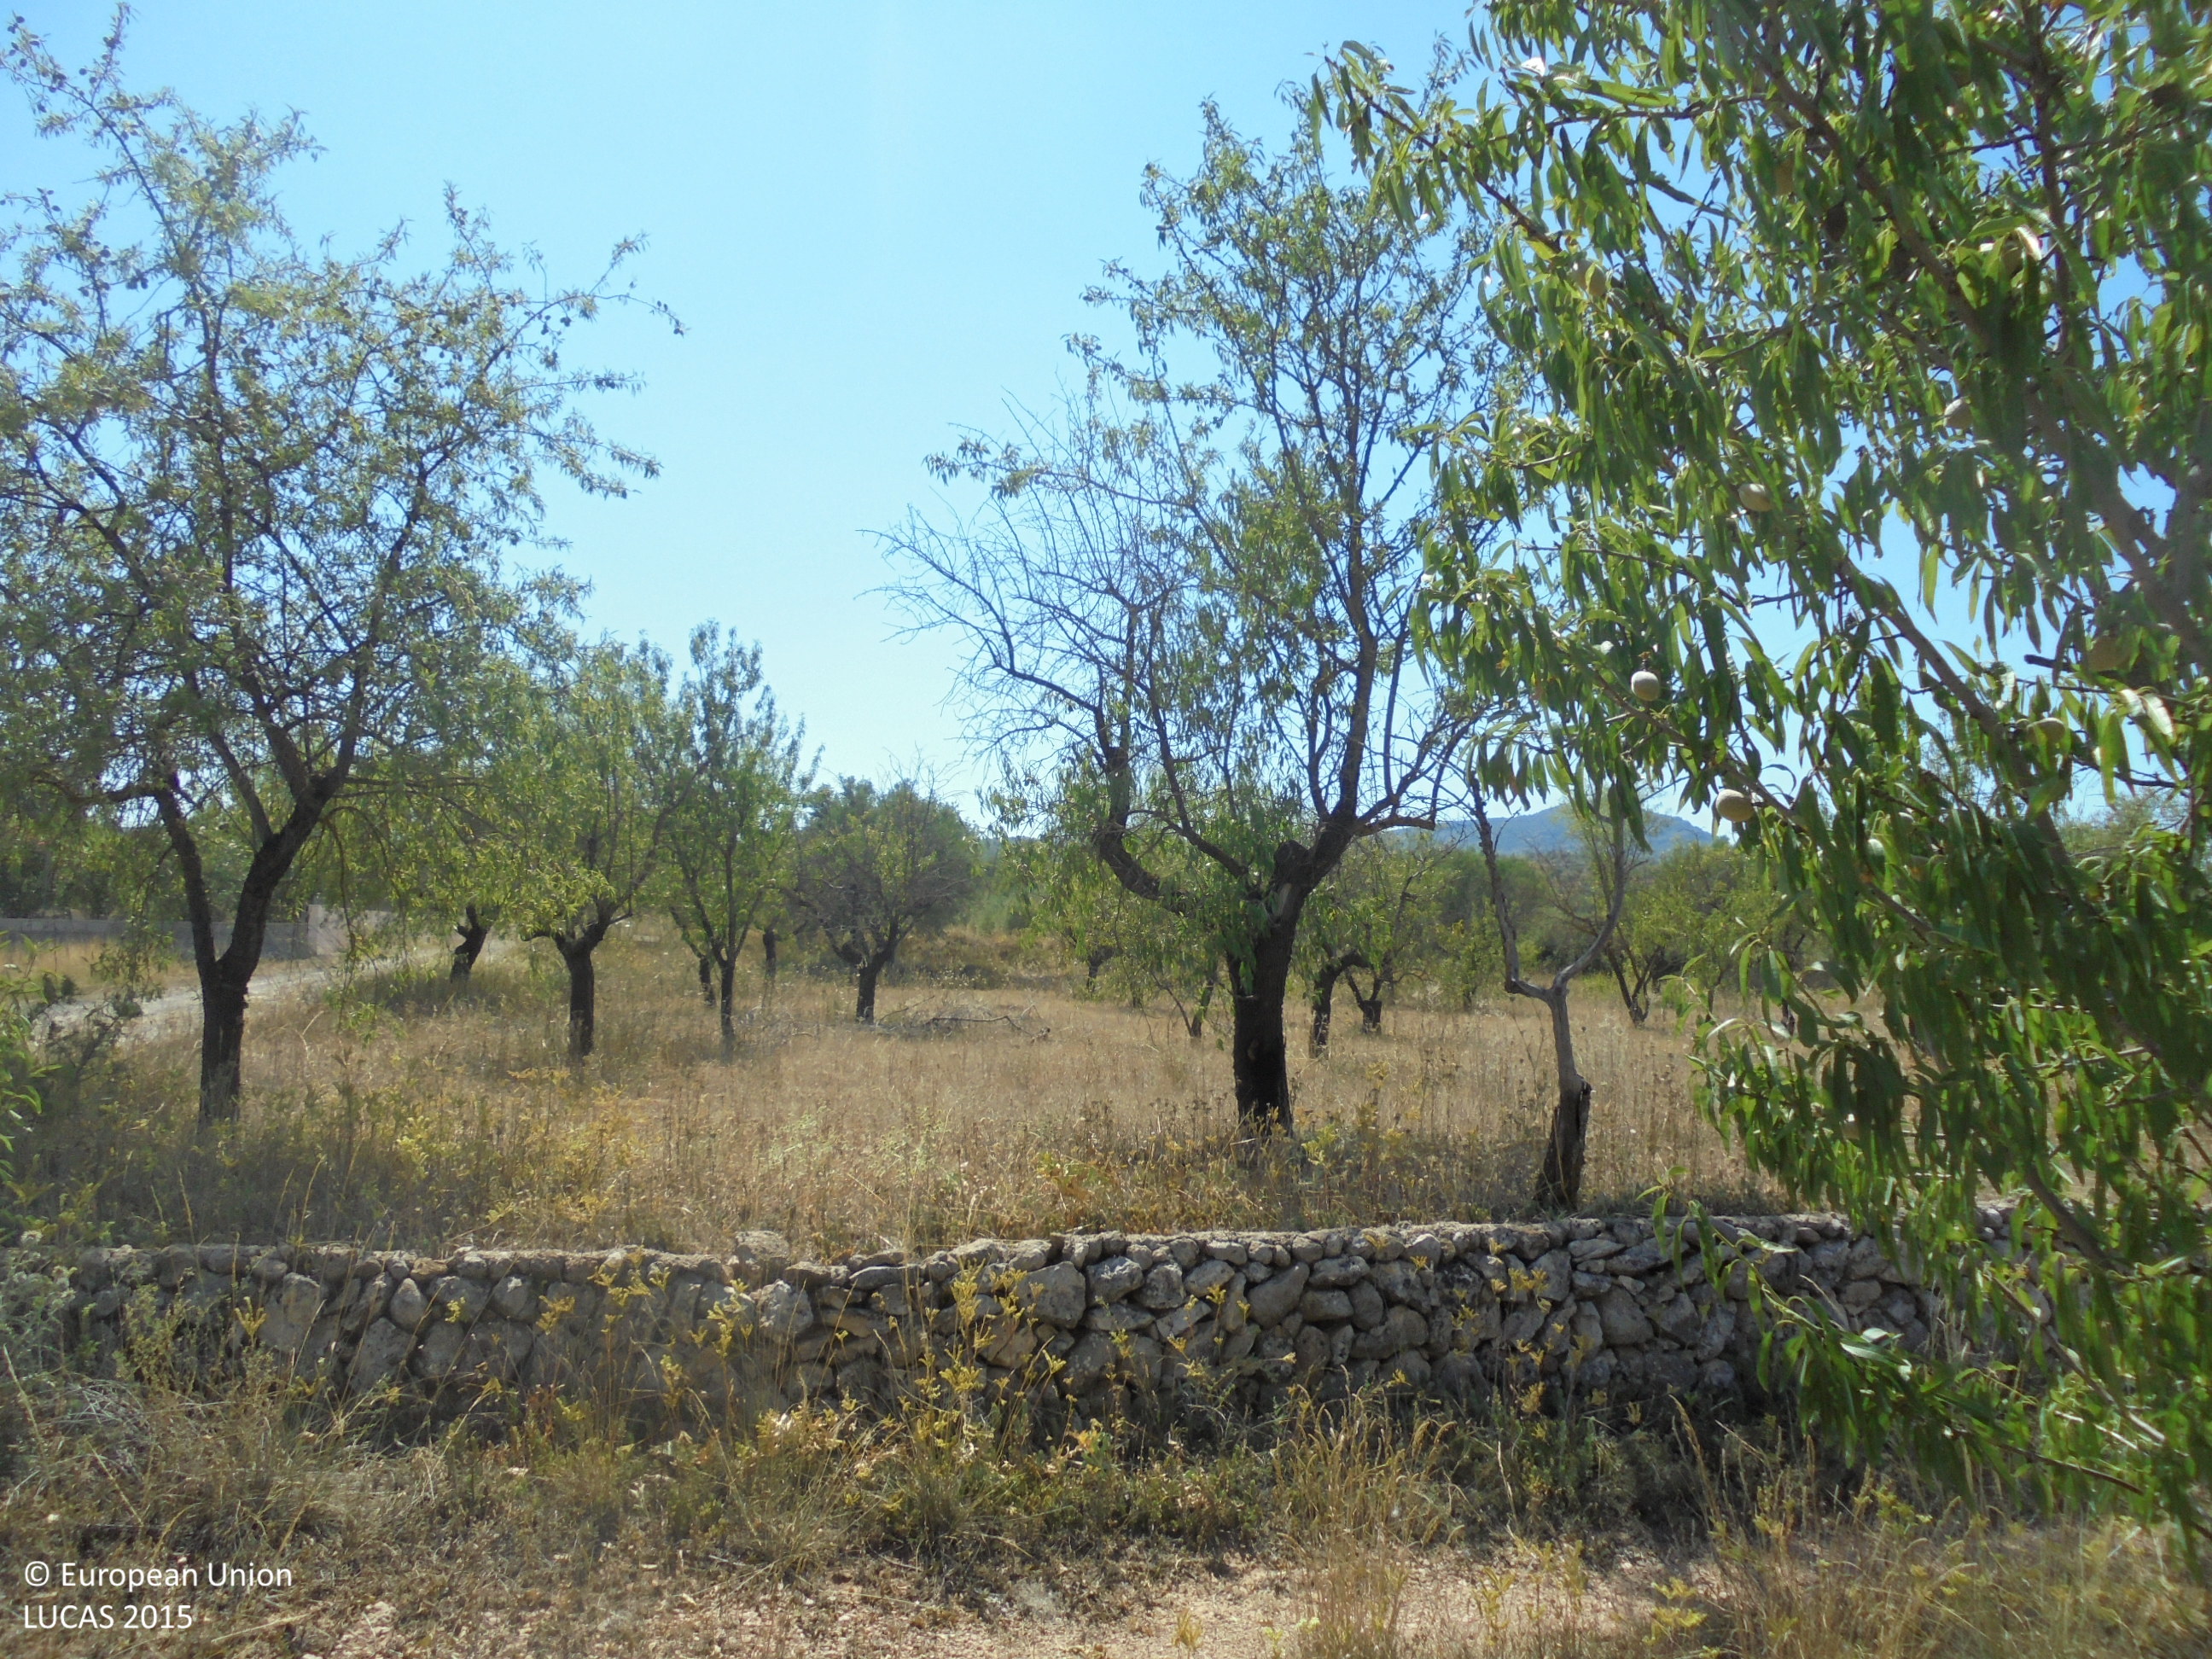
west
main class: Cropland
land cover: Nuts trees
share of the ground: 25 - 50 %
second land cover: Spontaneously vegetated surfaces
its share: 50 - 75 %
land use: Agriculture (excluding fallow land and kitchen gardens)
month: July
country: ES
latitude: 39.0385
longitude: -1.0521
